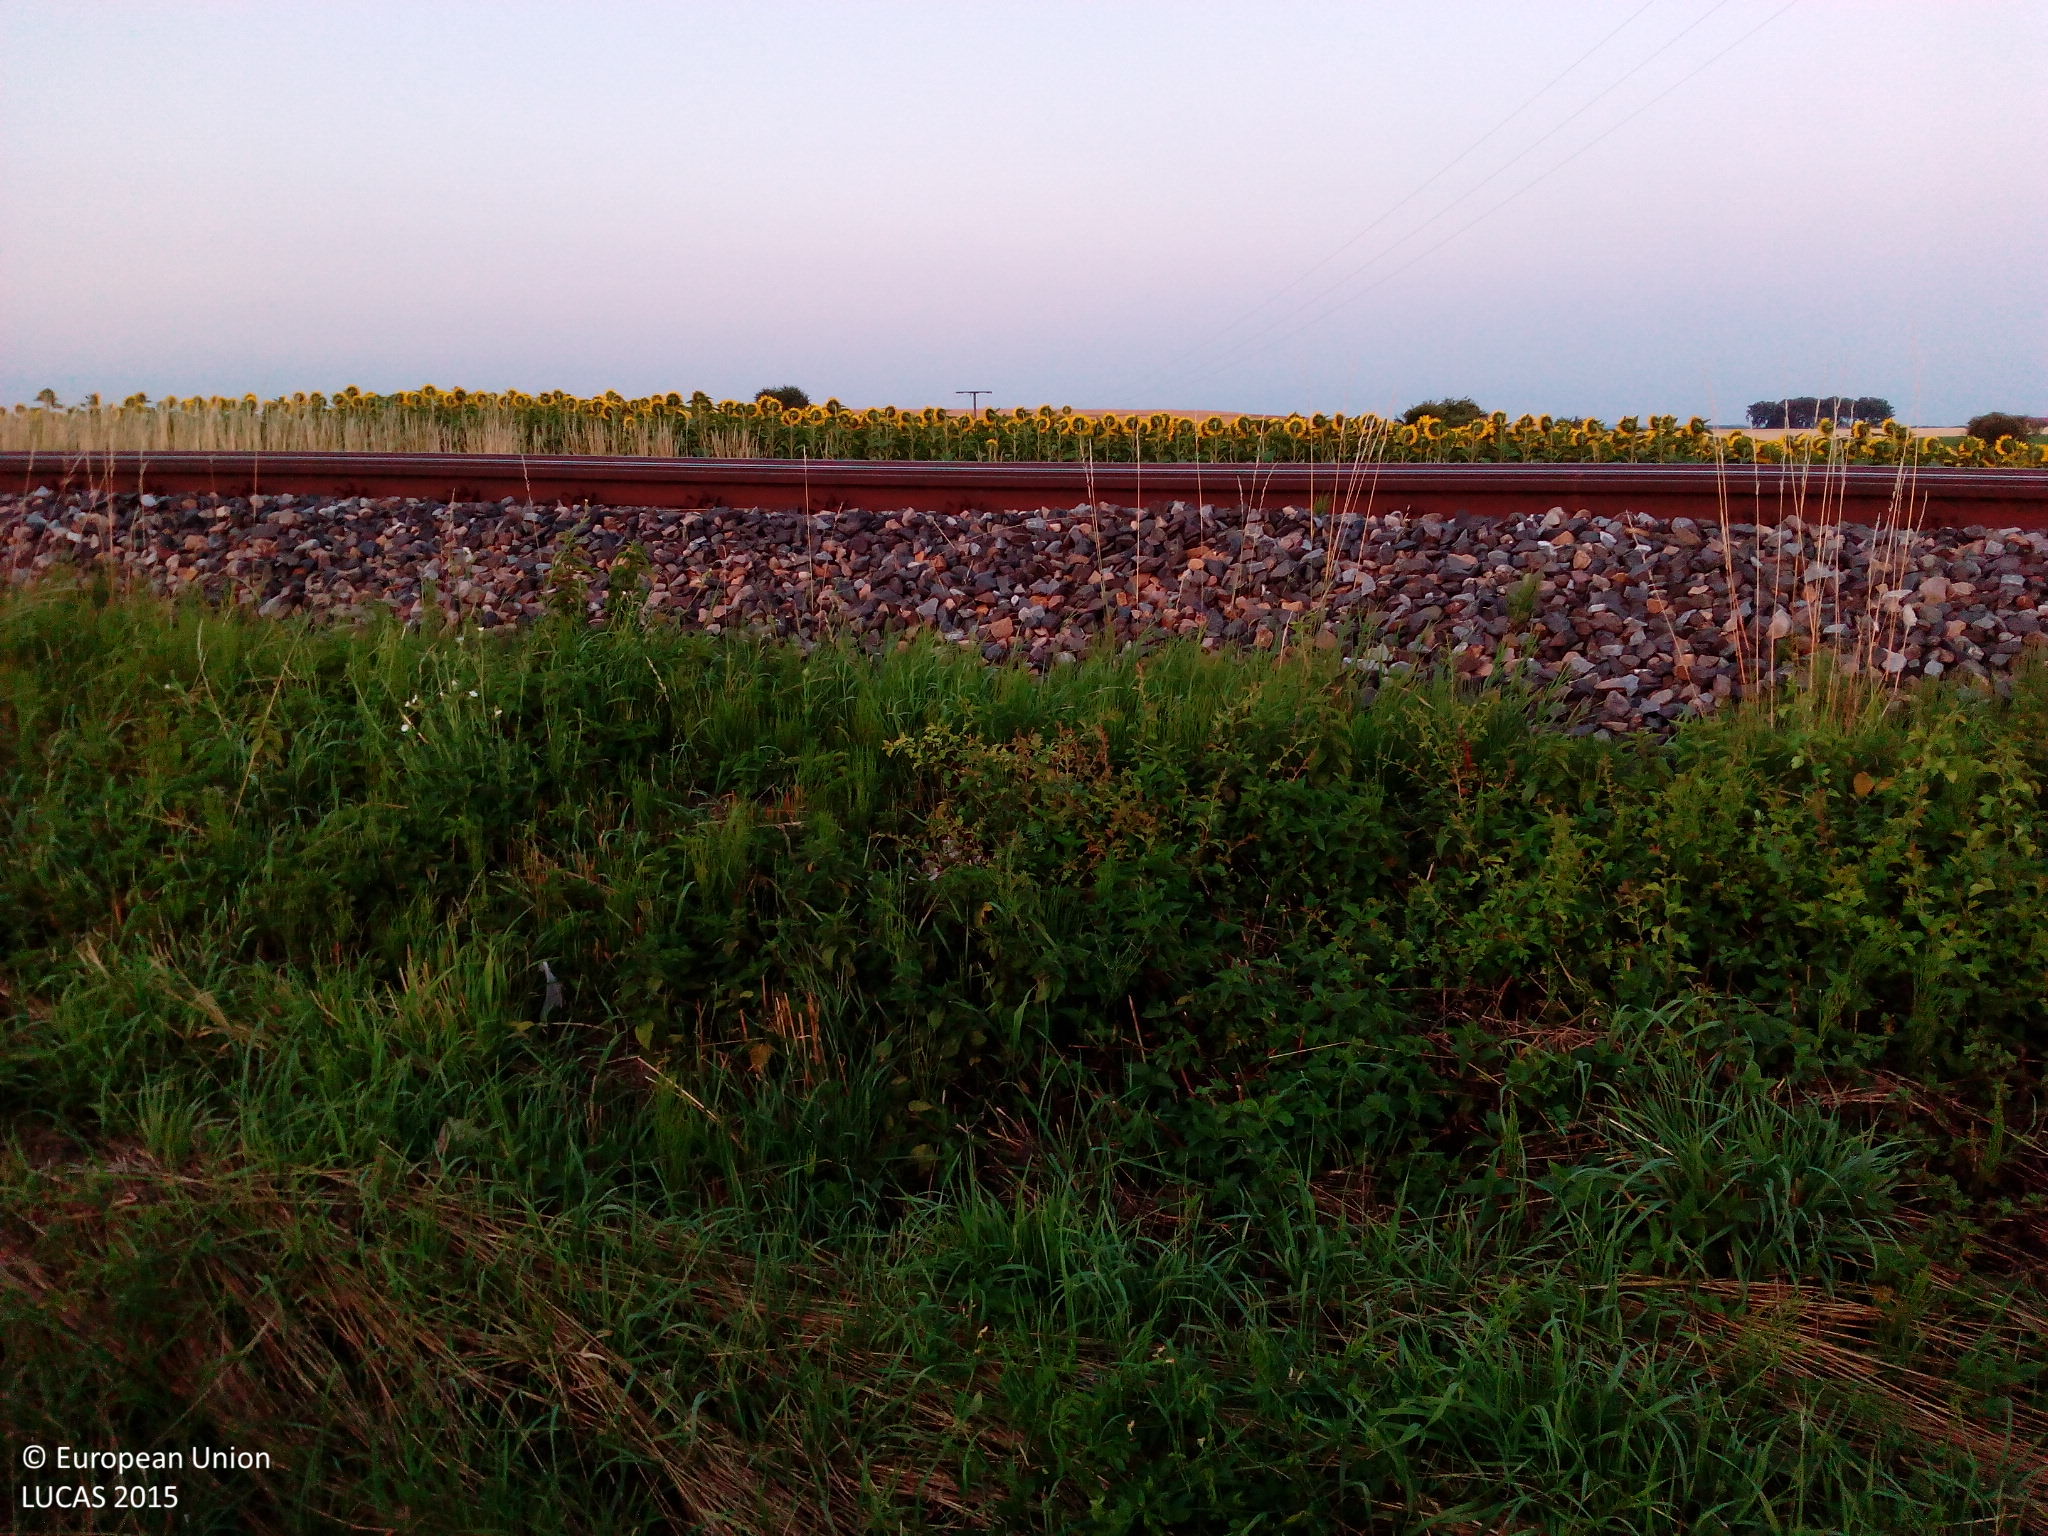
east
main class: Cropland
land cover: Rape and turnip rape
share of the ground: > 75 %
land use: Agriculture (excluding fallow land and kitchen gardens)
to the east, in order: Tracks; Grass margins; Electric lines; Railways; Grass margins; Sunflower; Sugar beet; Electric lines; Sugar beet; Grass margins; Paved roads, cycling and walking lanes; Ditches and canals; Common wheat
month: July
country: DE
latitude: 49.6806
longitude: 9.9030
